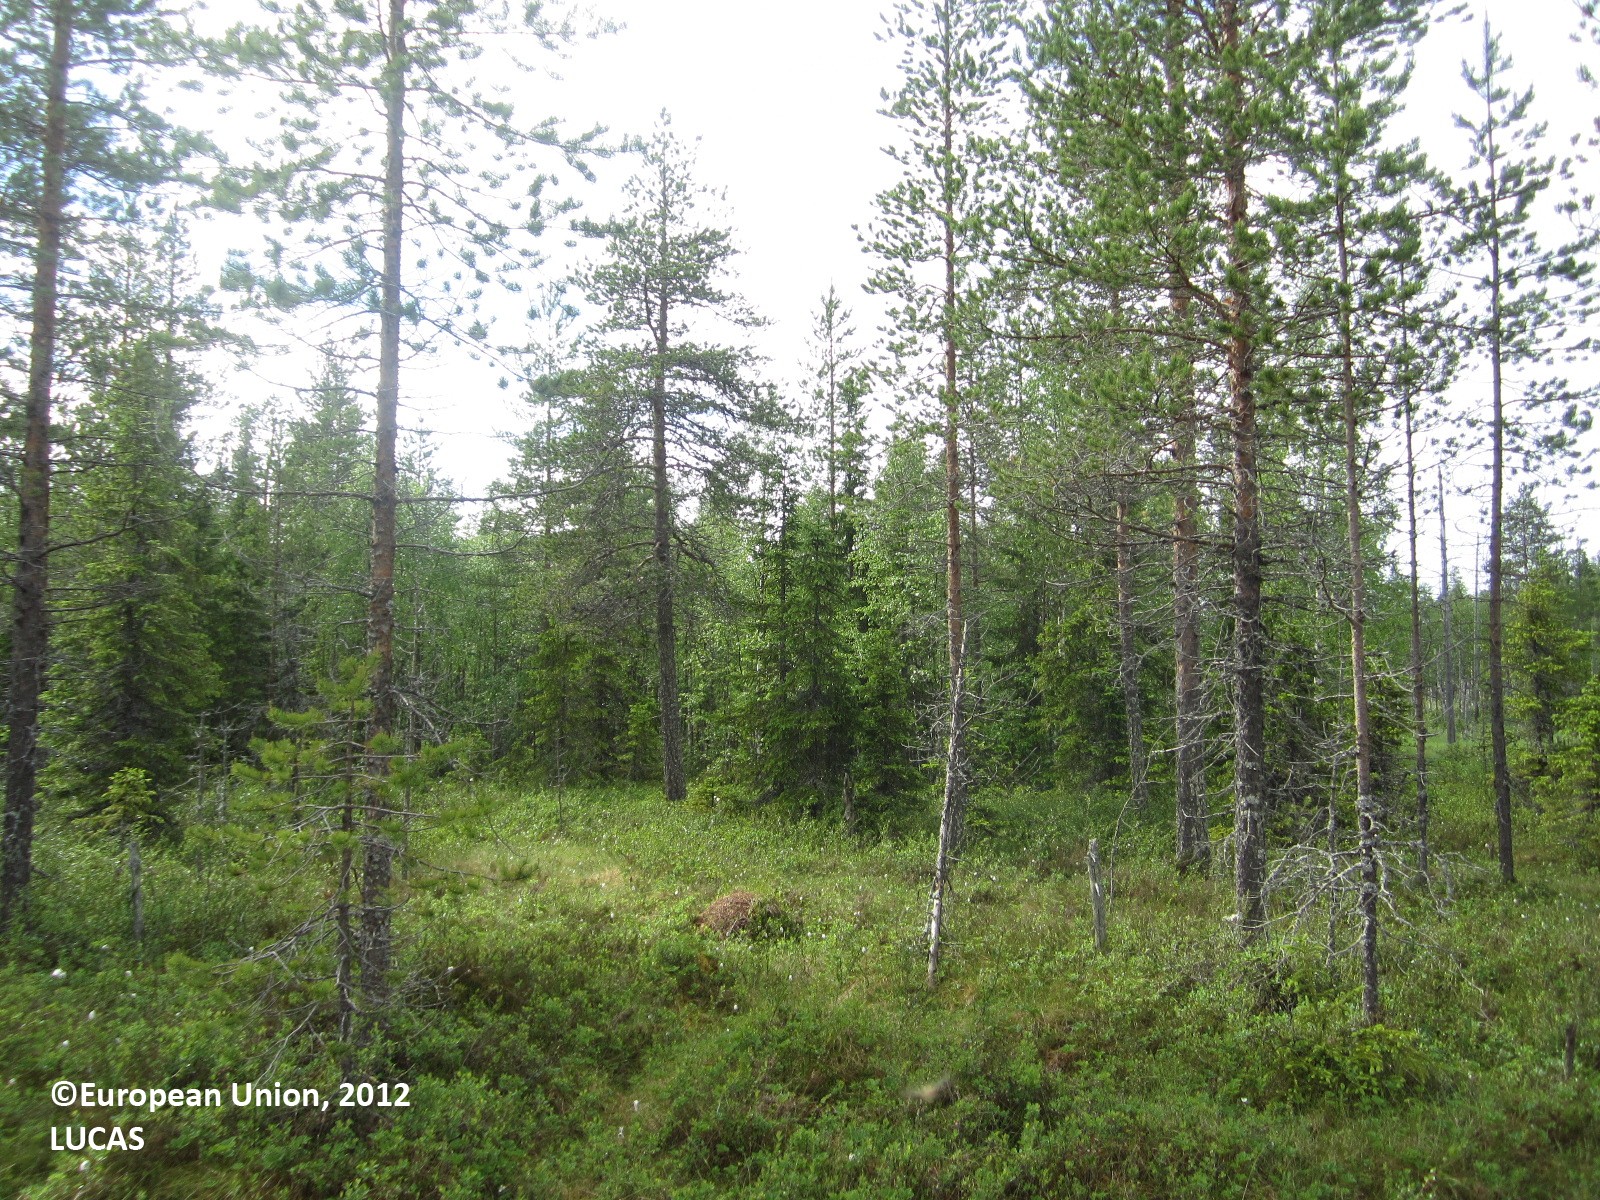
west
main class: Woodland
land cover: Pine dominated coniferous woodland
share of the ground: 10 - 25 %
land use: Semi-natural and natural areas not in use
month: June
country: FI
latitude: 64.6393
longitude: 29.8752
